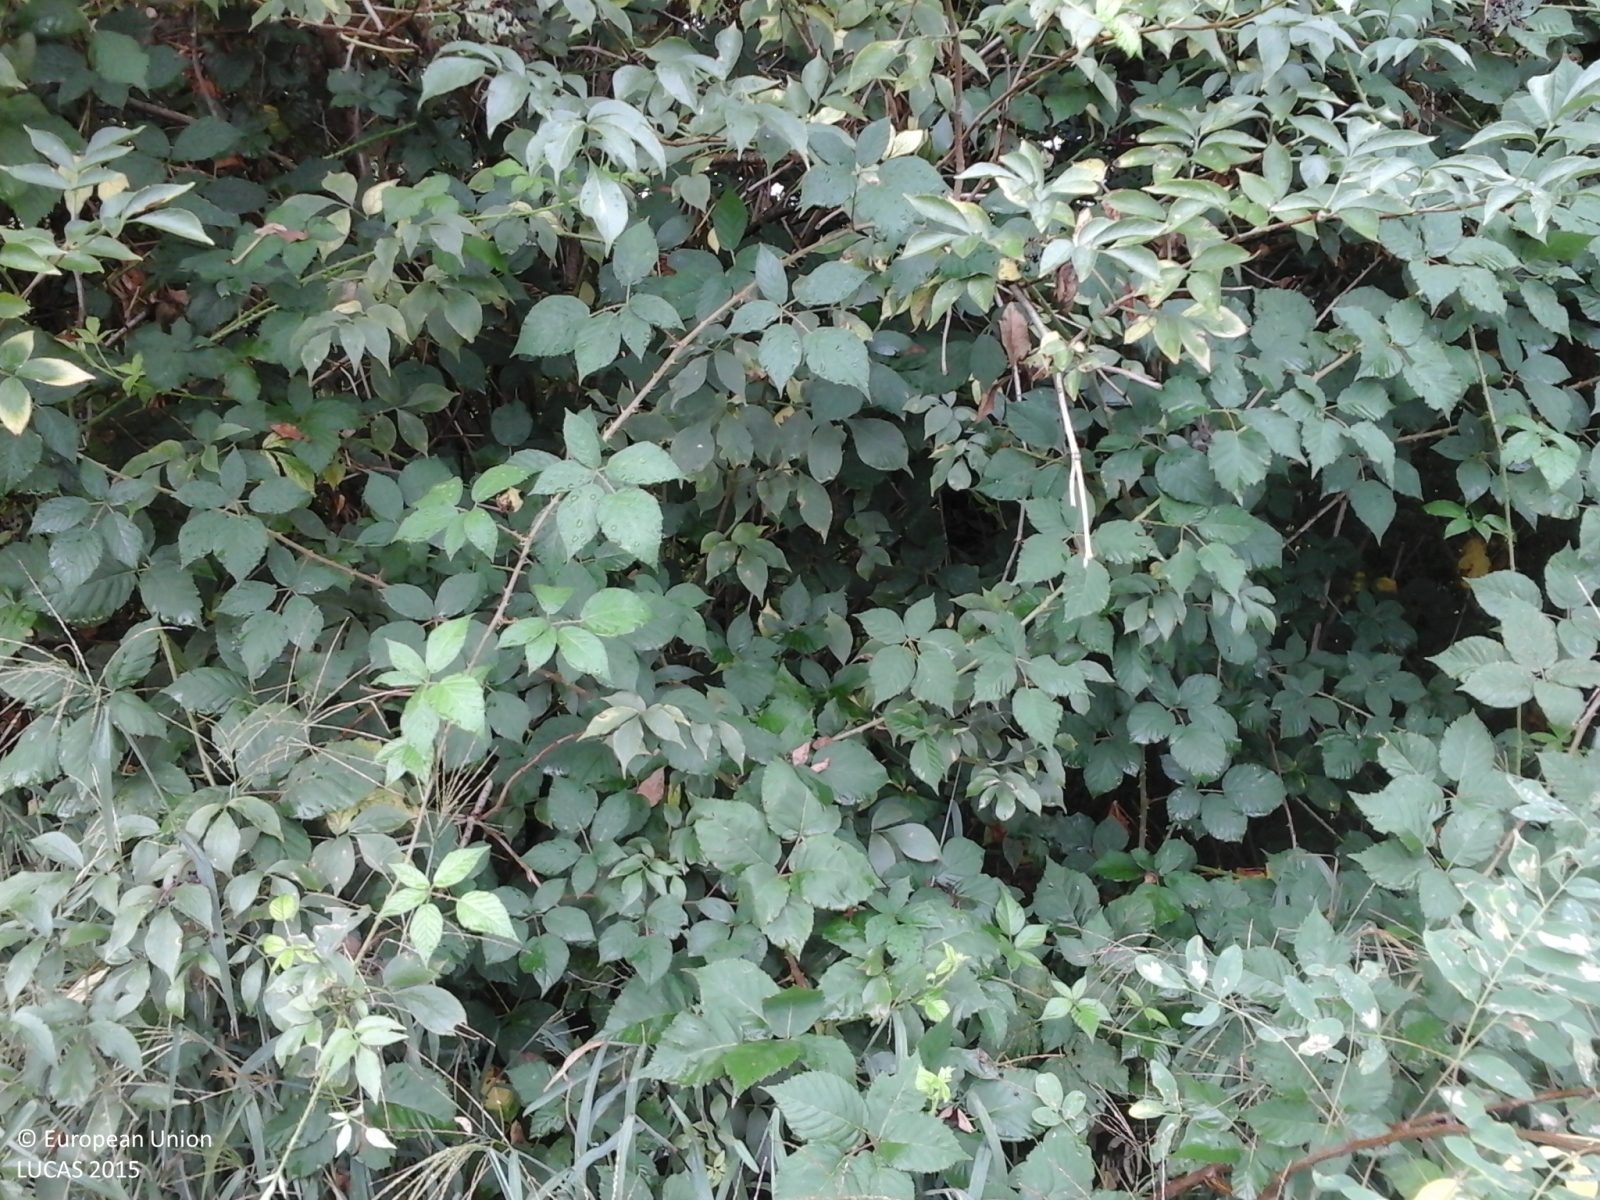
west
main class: Cropland
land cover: Soya
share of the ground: > 75 %
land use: Agriculture (excluding fallow land and kitchen gardens)
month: August
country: IT
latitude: 45.6795
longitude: 8.9617
